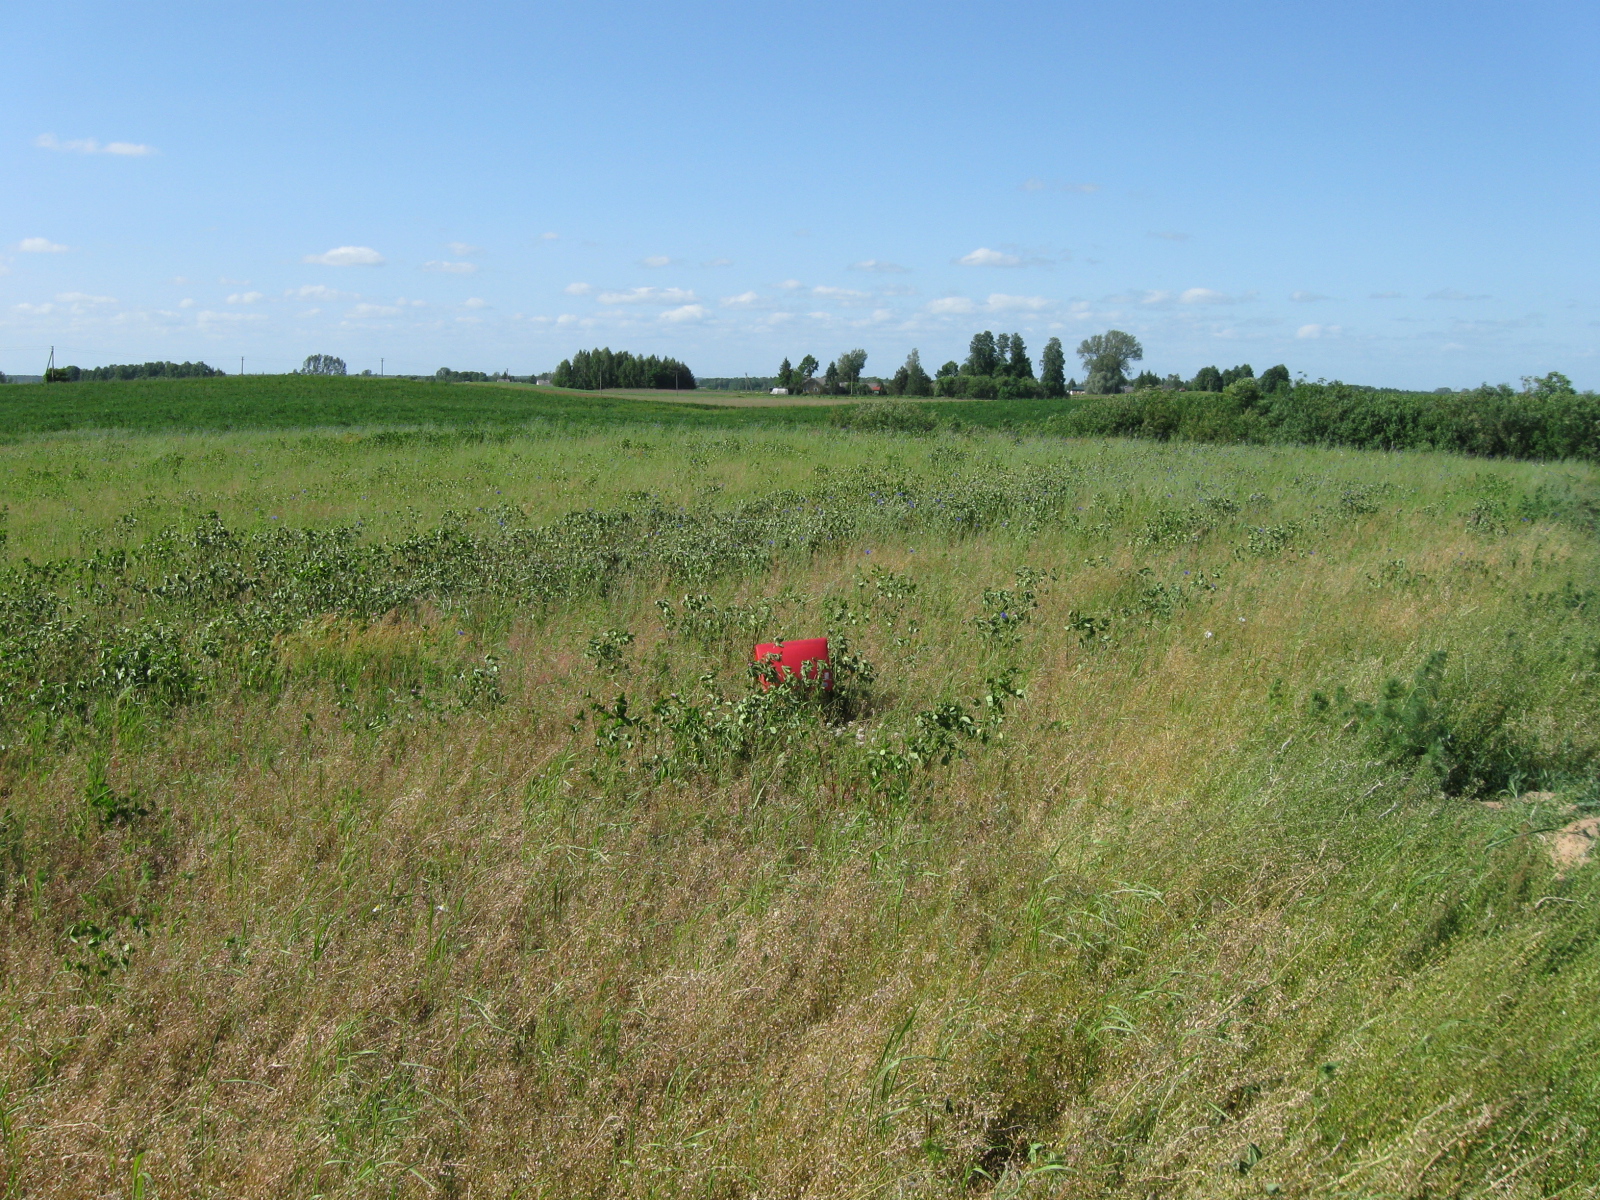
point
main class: Grassland
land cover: Spontaneously vegetated surfaces
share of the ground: > 75 %
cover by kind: herbaceous plants 100 %
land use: Fallow land
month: June
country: LT
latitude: 54.4469
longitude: 23.6717
